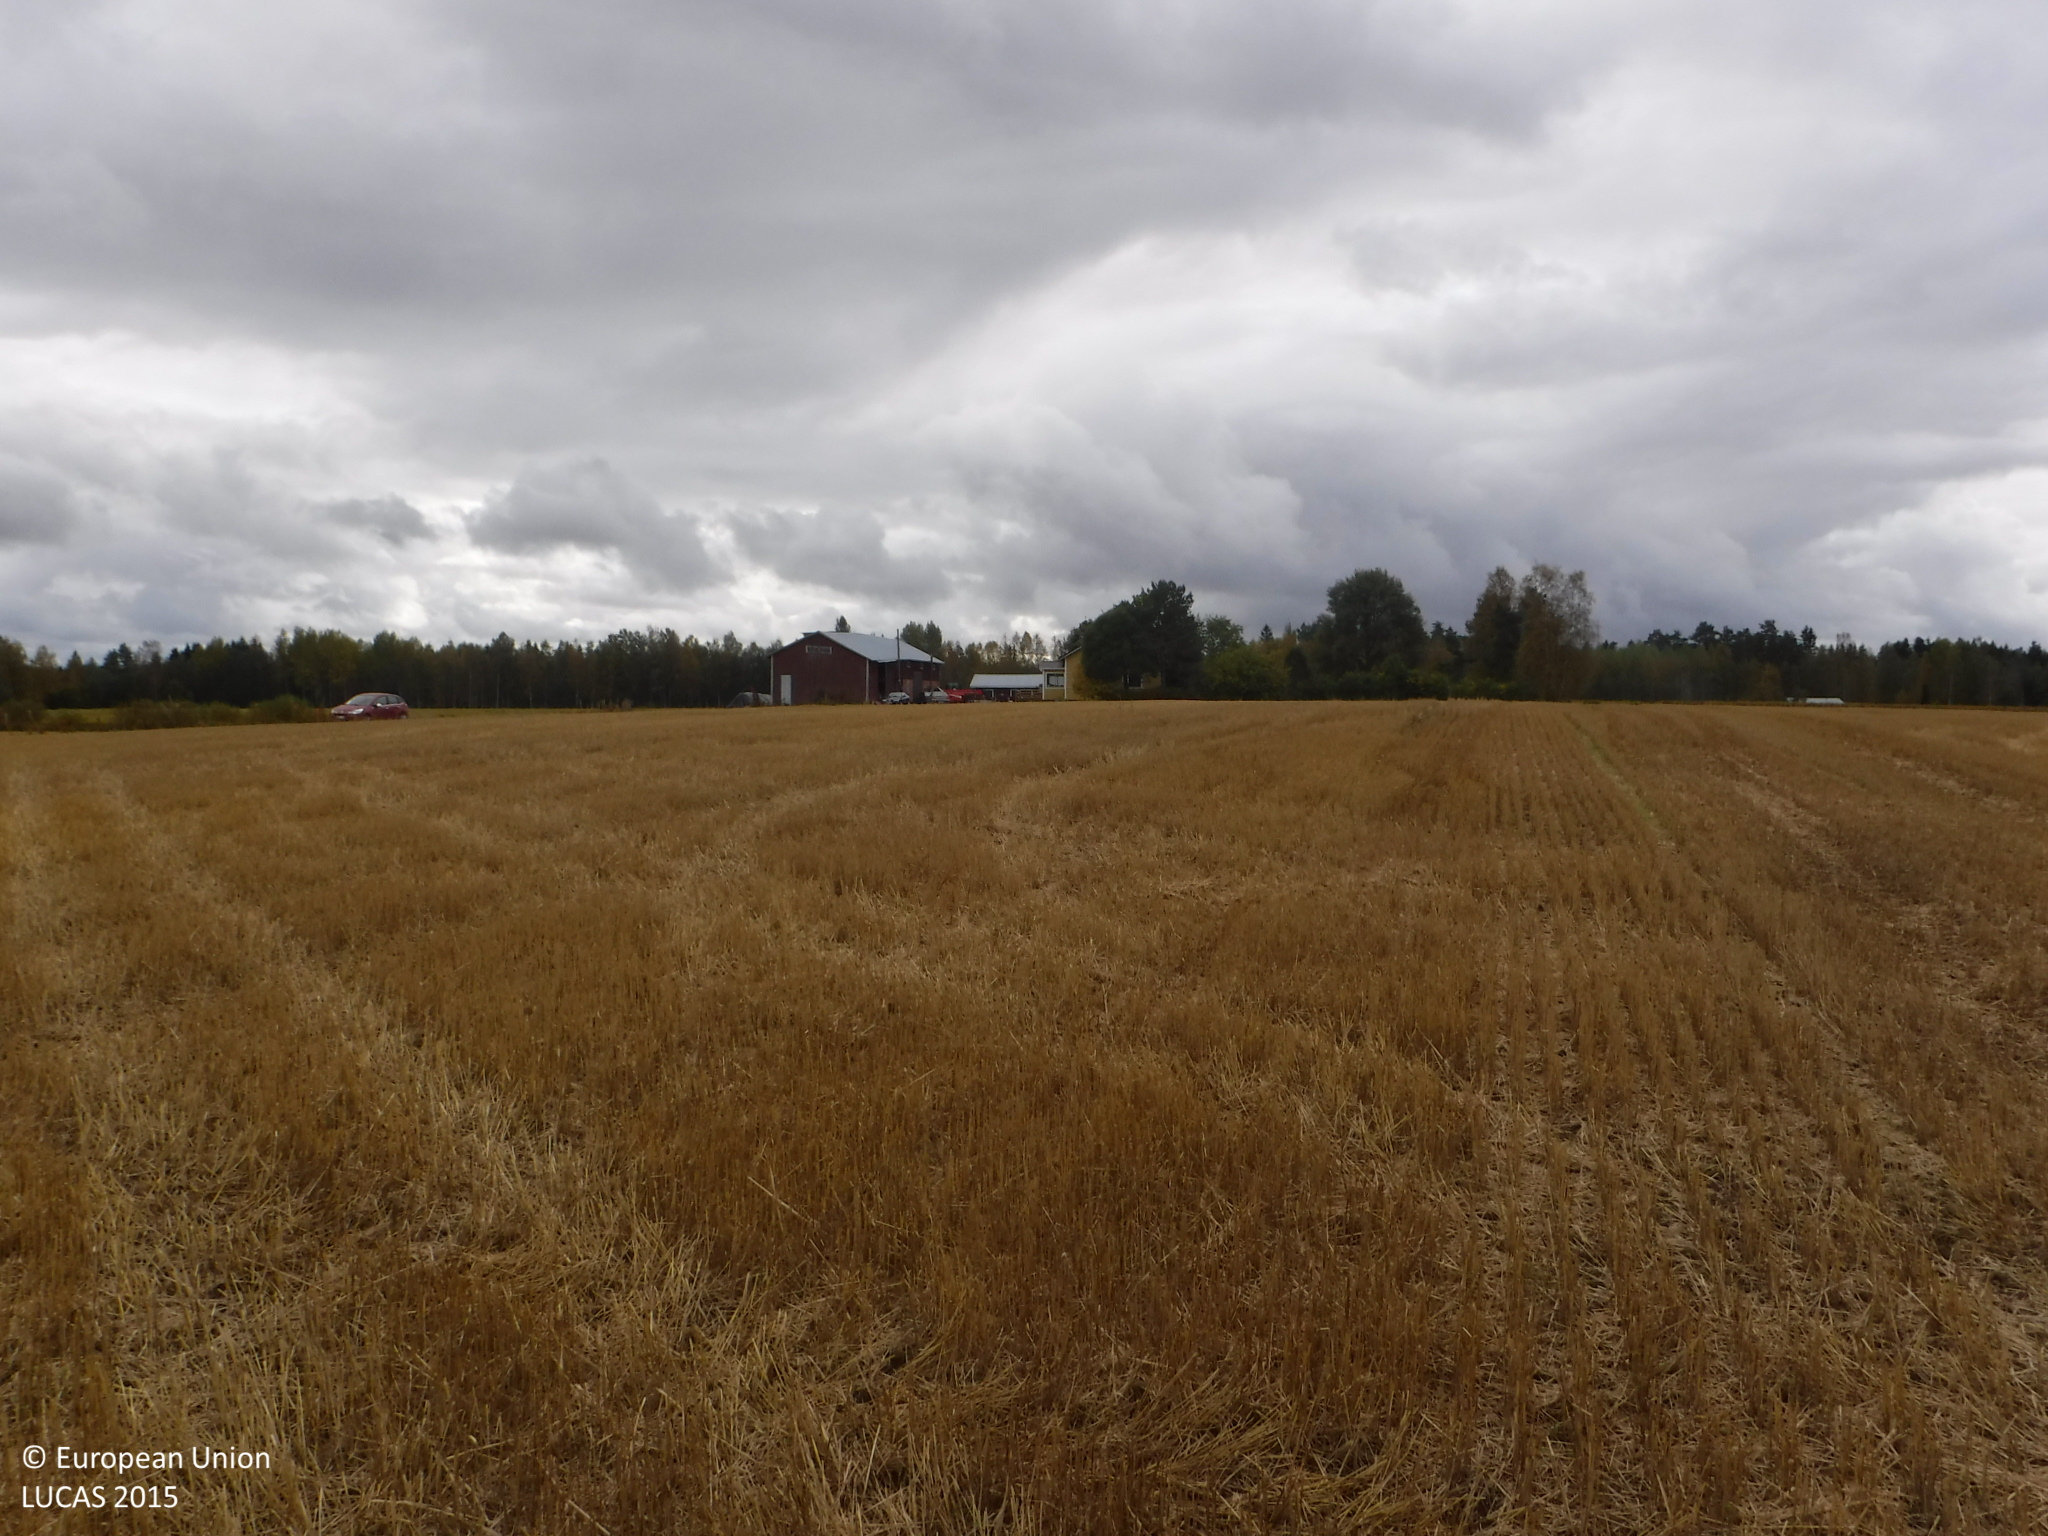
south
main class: Cropland
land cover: Barley
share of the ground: > 75 %
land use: Agriculture (excluding fallow land and kitchen gardens)
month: September
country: FI
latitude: 62.0914
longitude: 22.2549
